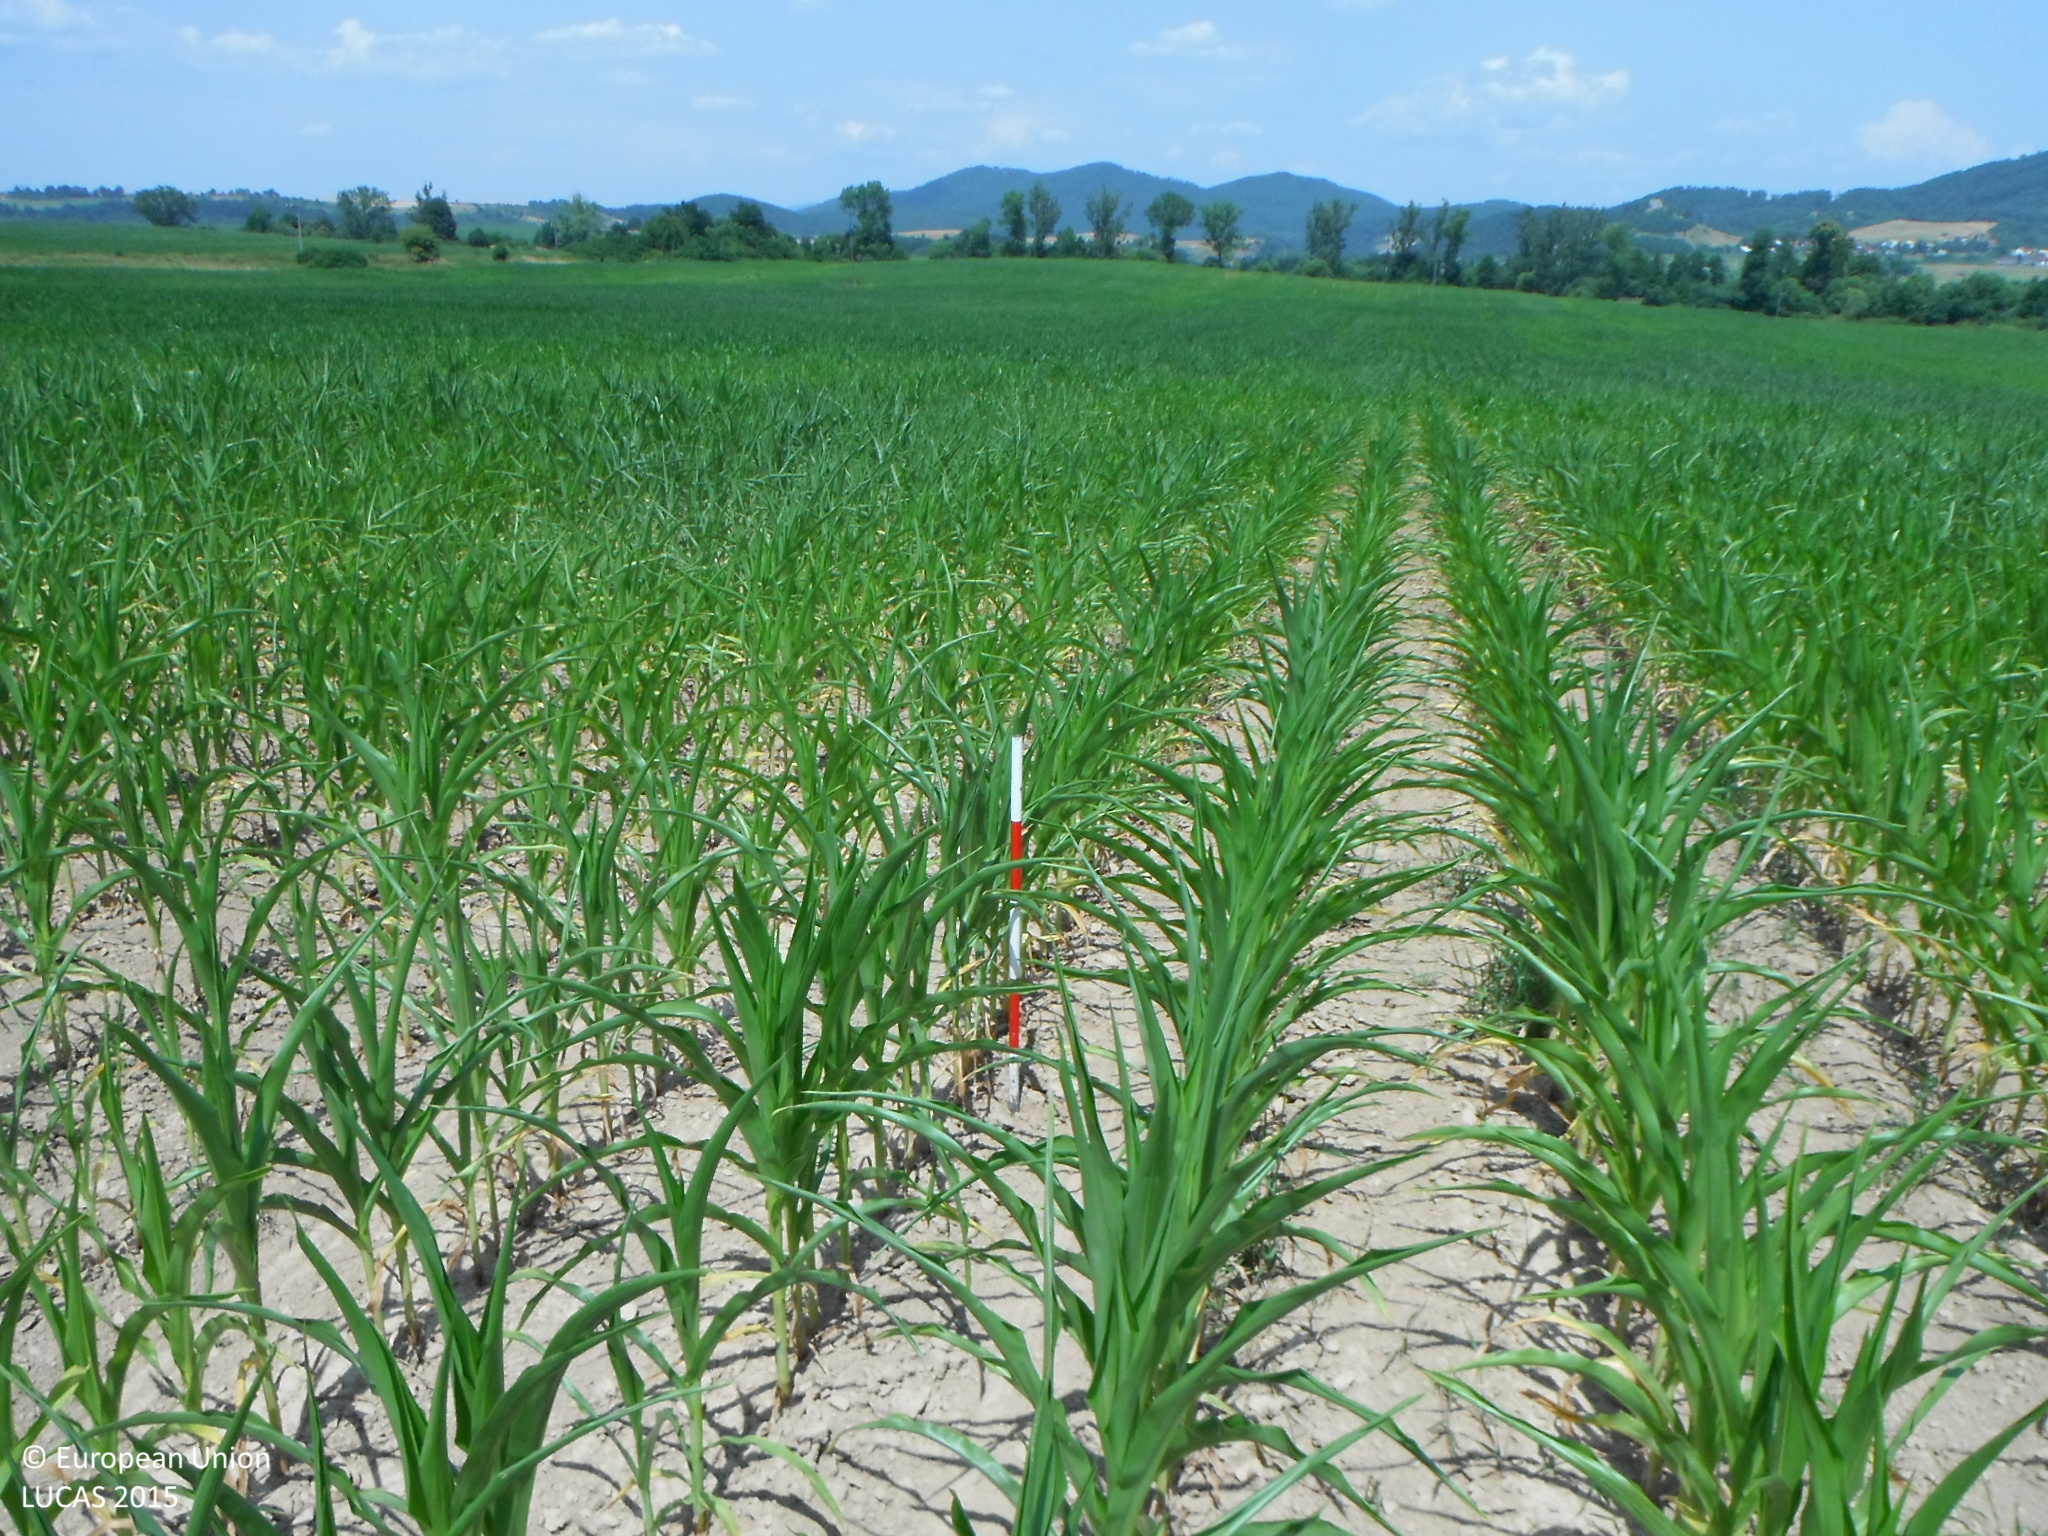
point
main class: Cropland
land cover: Maize
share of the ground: 50 - 75 %
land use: Agriculture (excluding fallow land and kitchen gardens)
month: July
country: SK
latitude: 48.4803
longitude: 19.0989
